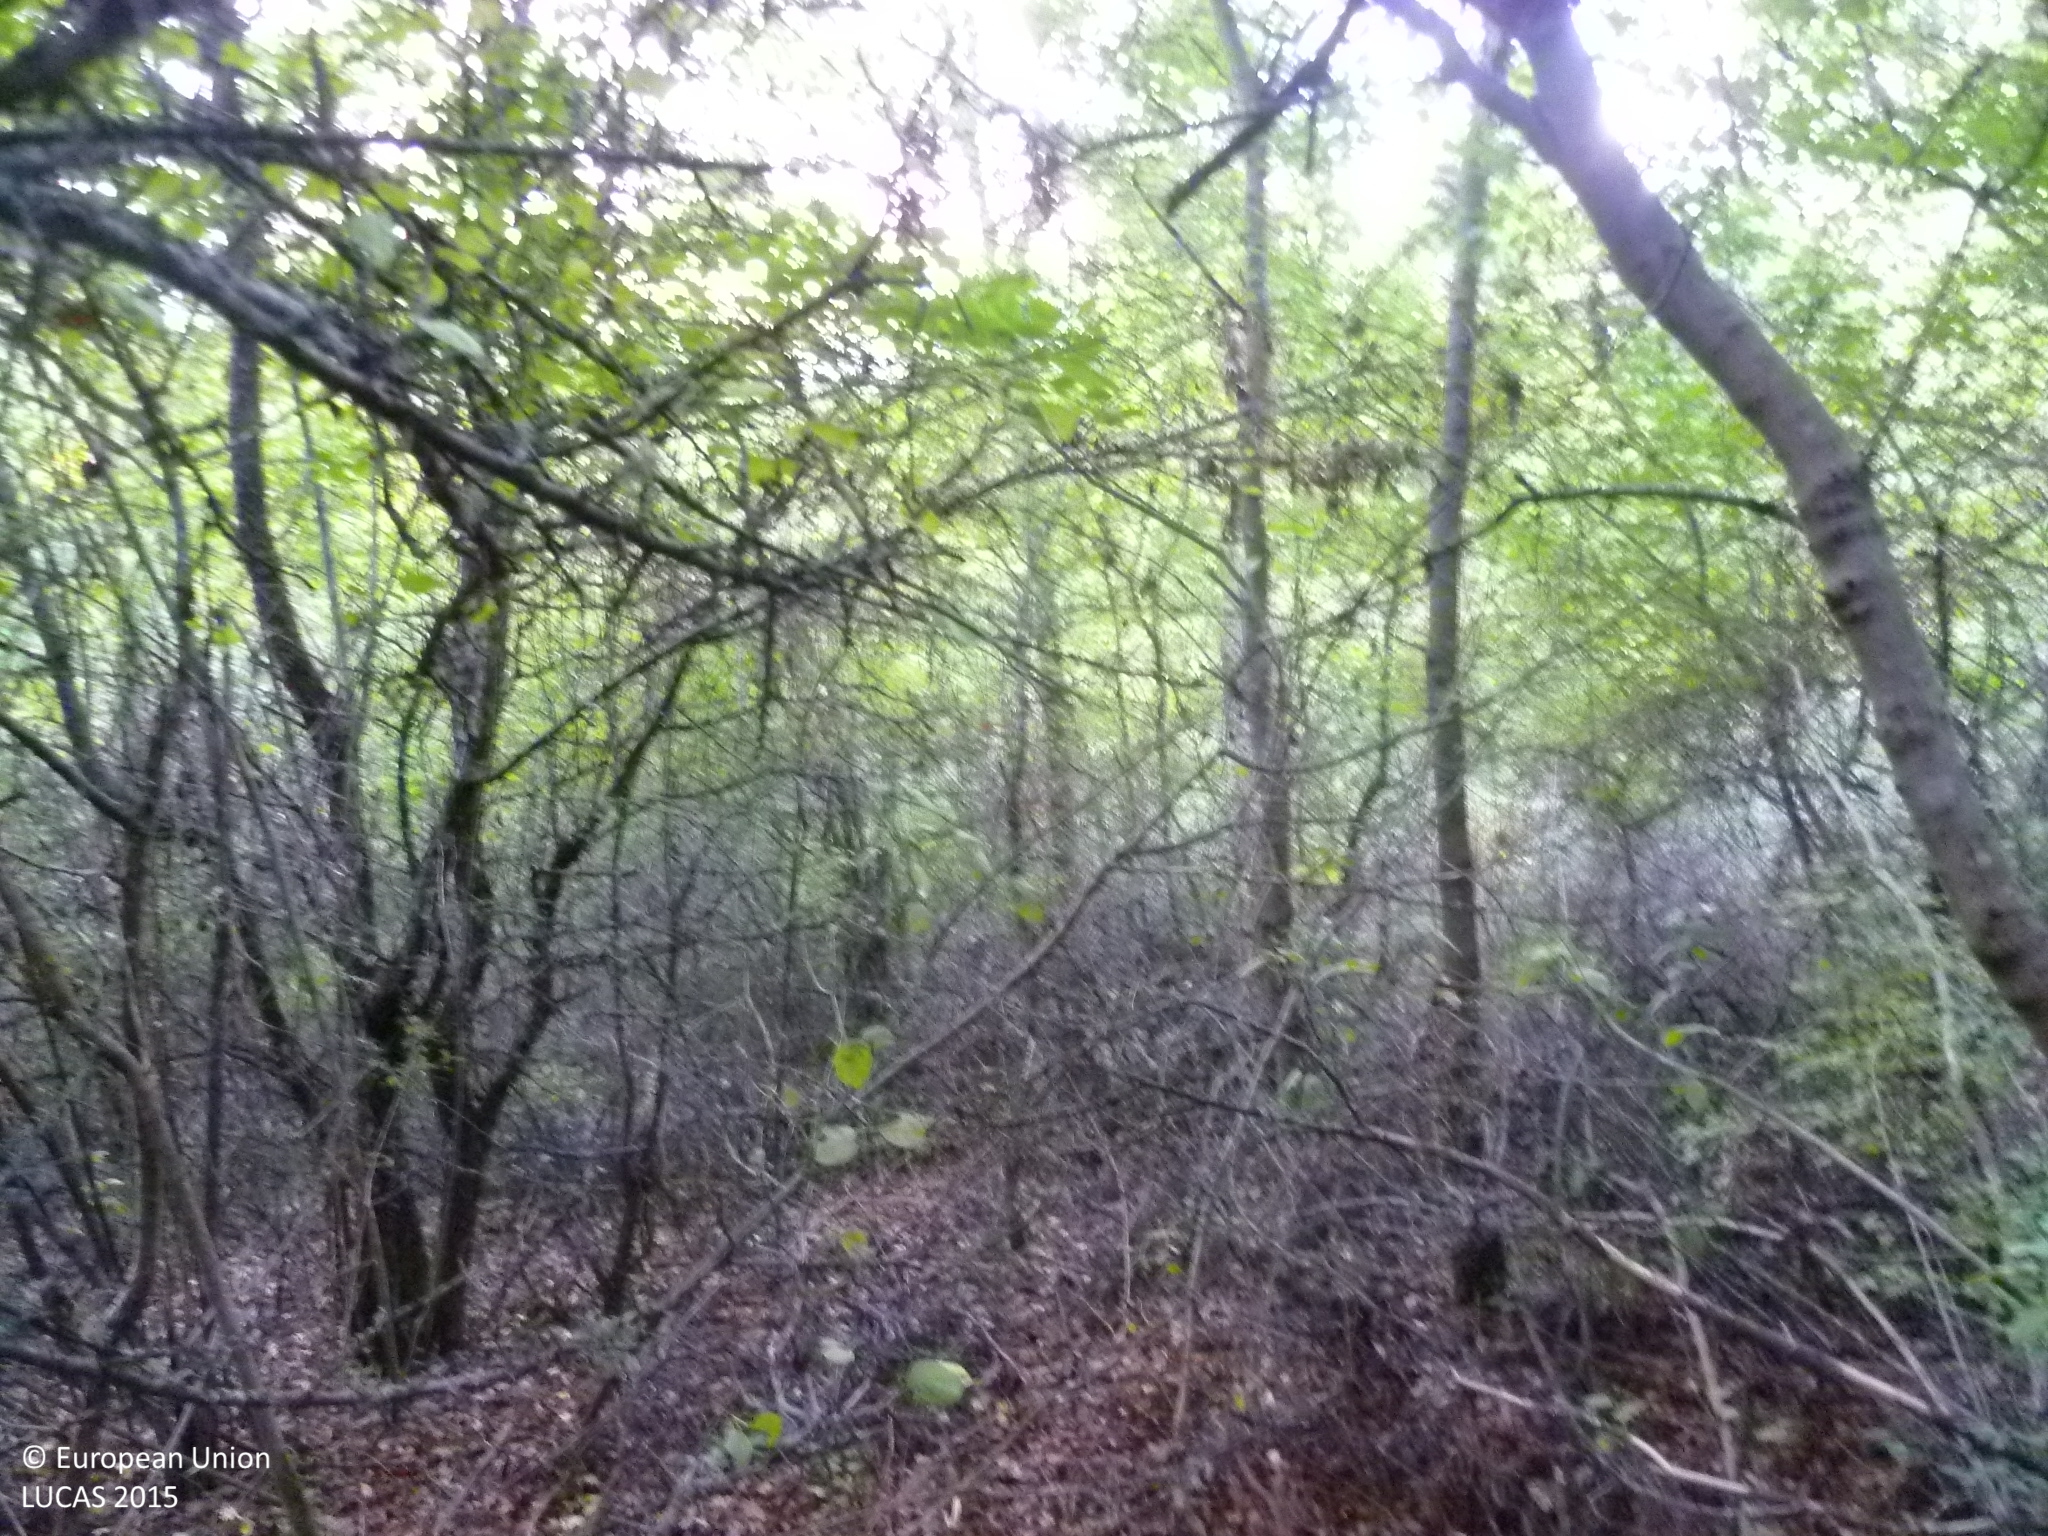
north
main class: Woodland
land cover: Broadleaved woodland
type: mesophytic deciduous forest
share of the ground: 50 - 75 %
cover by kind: broadleaved forest trees 60 %, unconsolidated bare surface 30 %, shrubs 5 %, lichens and mosses 5 %
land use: Forestry
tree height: > 5 m
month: October
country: BG
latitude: 42.8234
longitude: 22.6619
